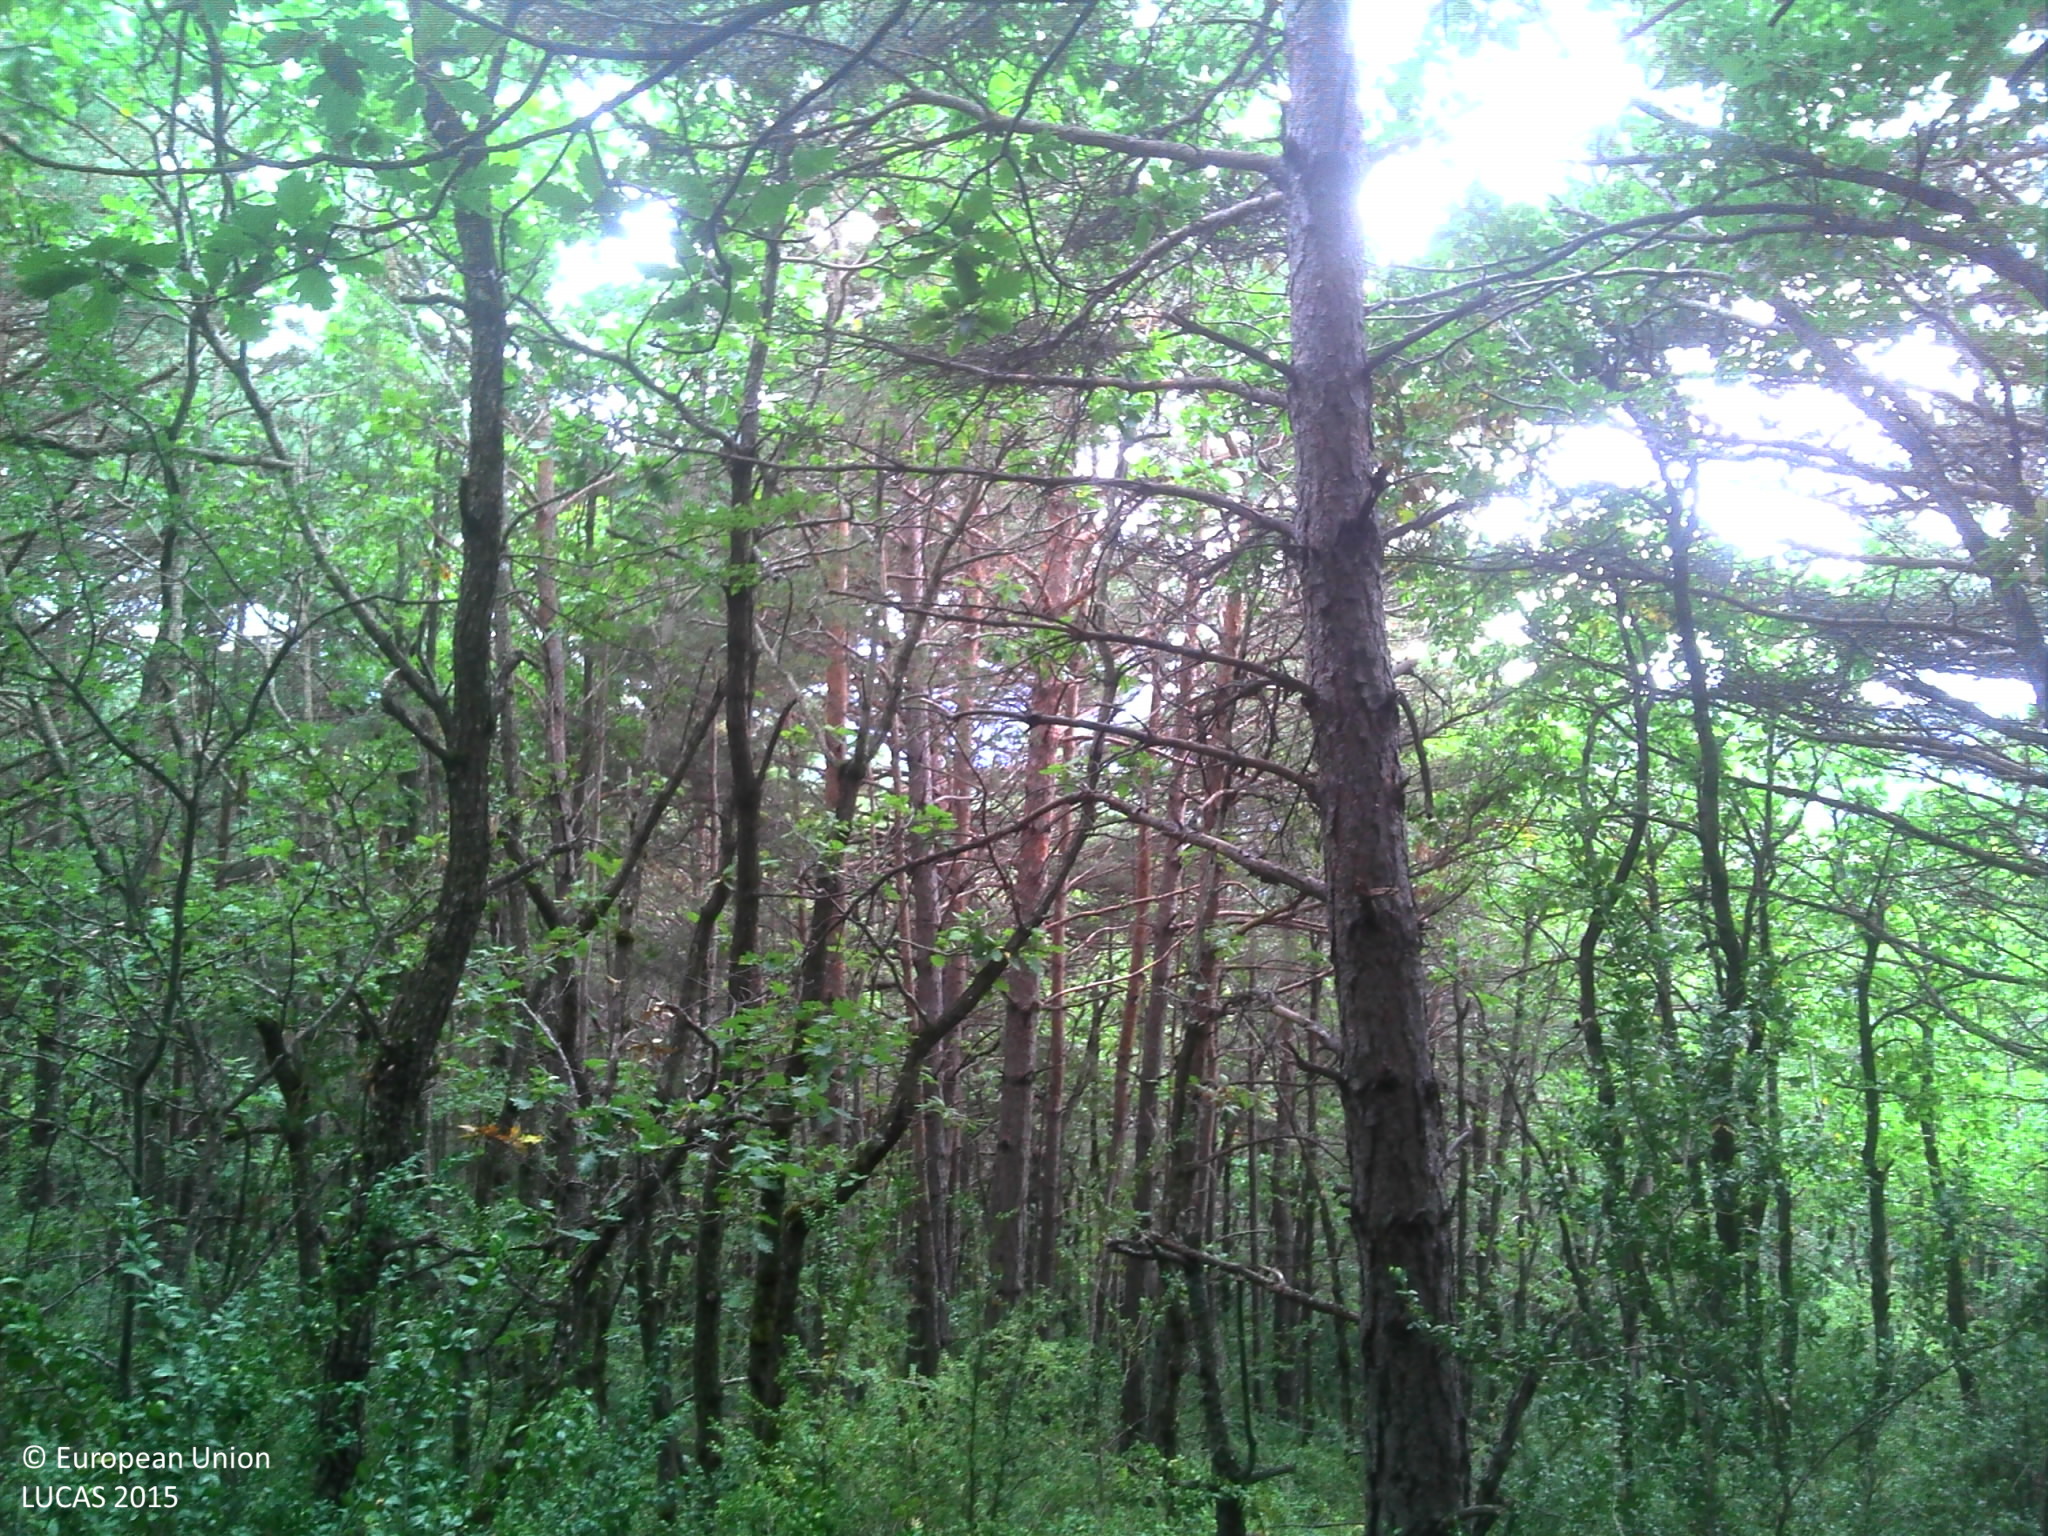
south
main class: Woodland
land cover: Pine dominated mixed woodland
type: alpine coniferous forest
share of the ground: > 75 %
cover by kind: broadleaved forest trees 50 %, coniferous forest trees 20 %, shrubs 20 %, herbaceous plants 10 %
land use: Forestry
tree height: > 5 m
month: September
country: FR
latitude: 44.5987
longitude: 5.5596
